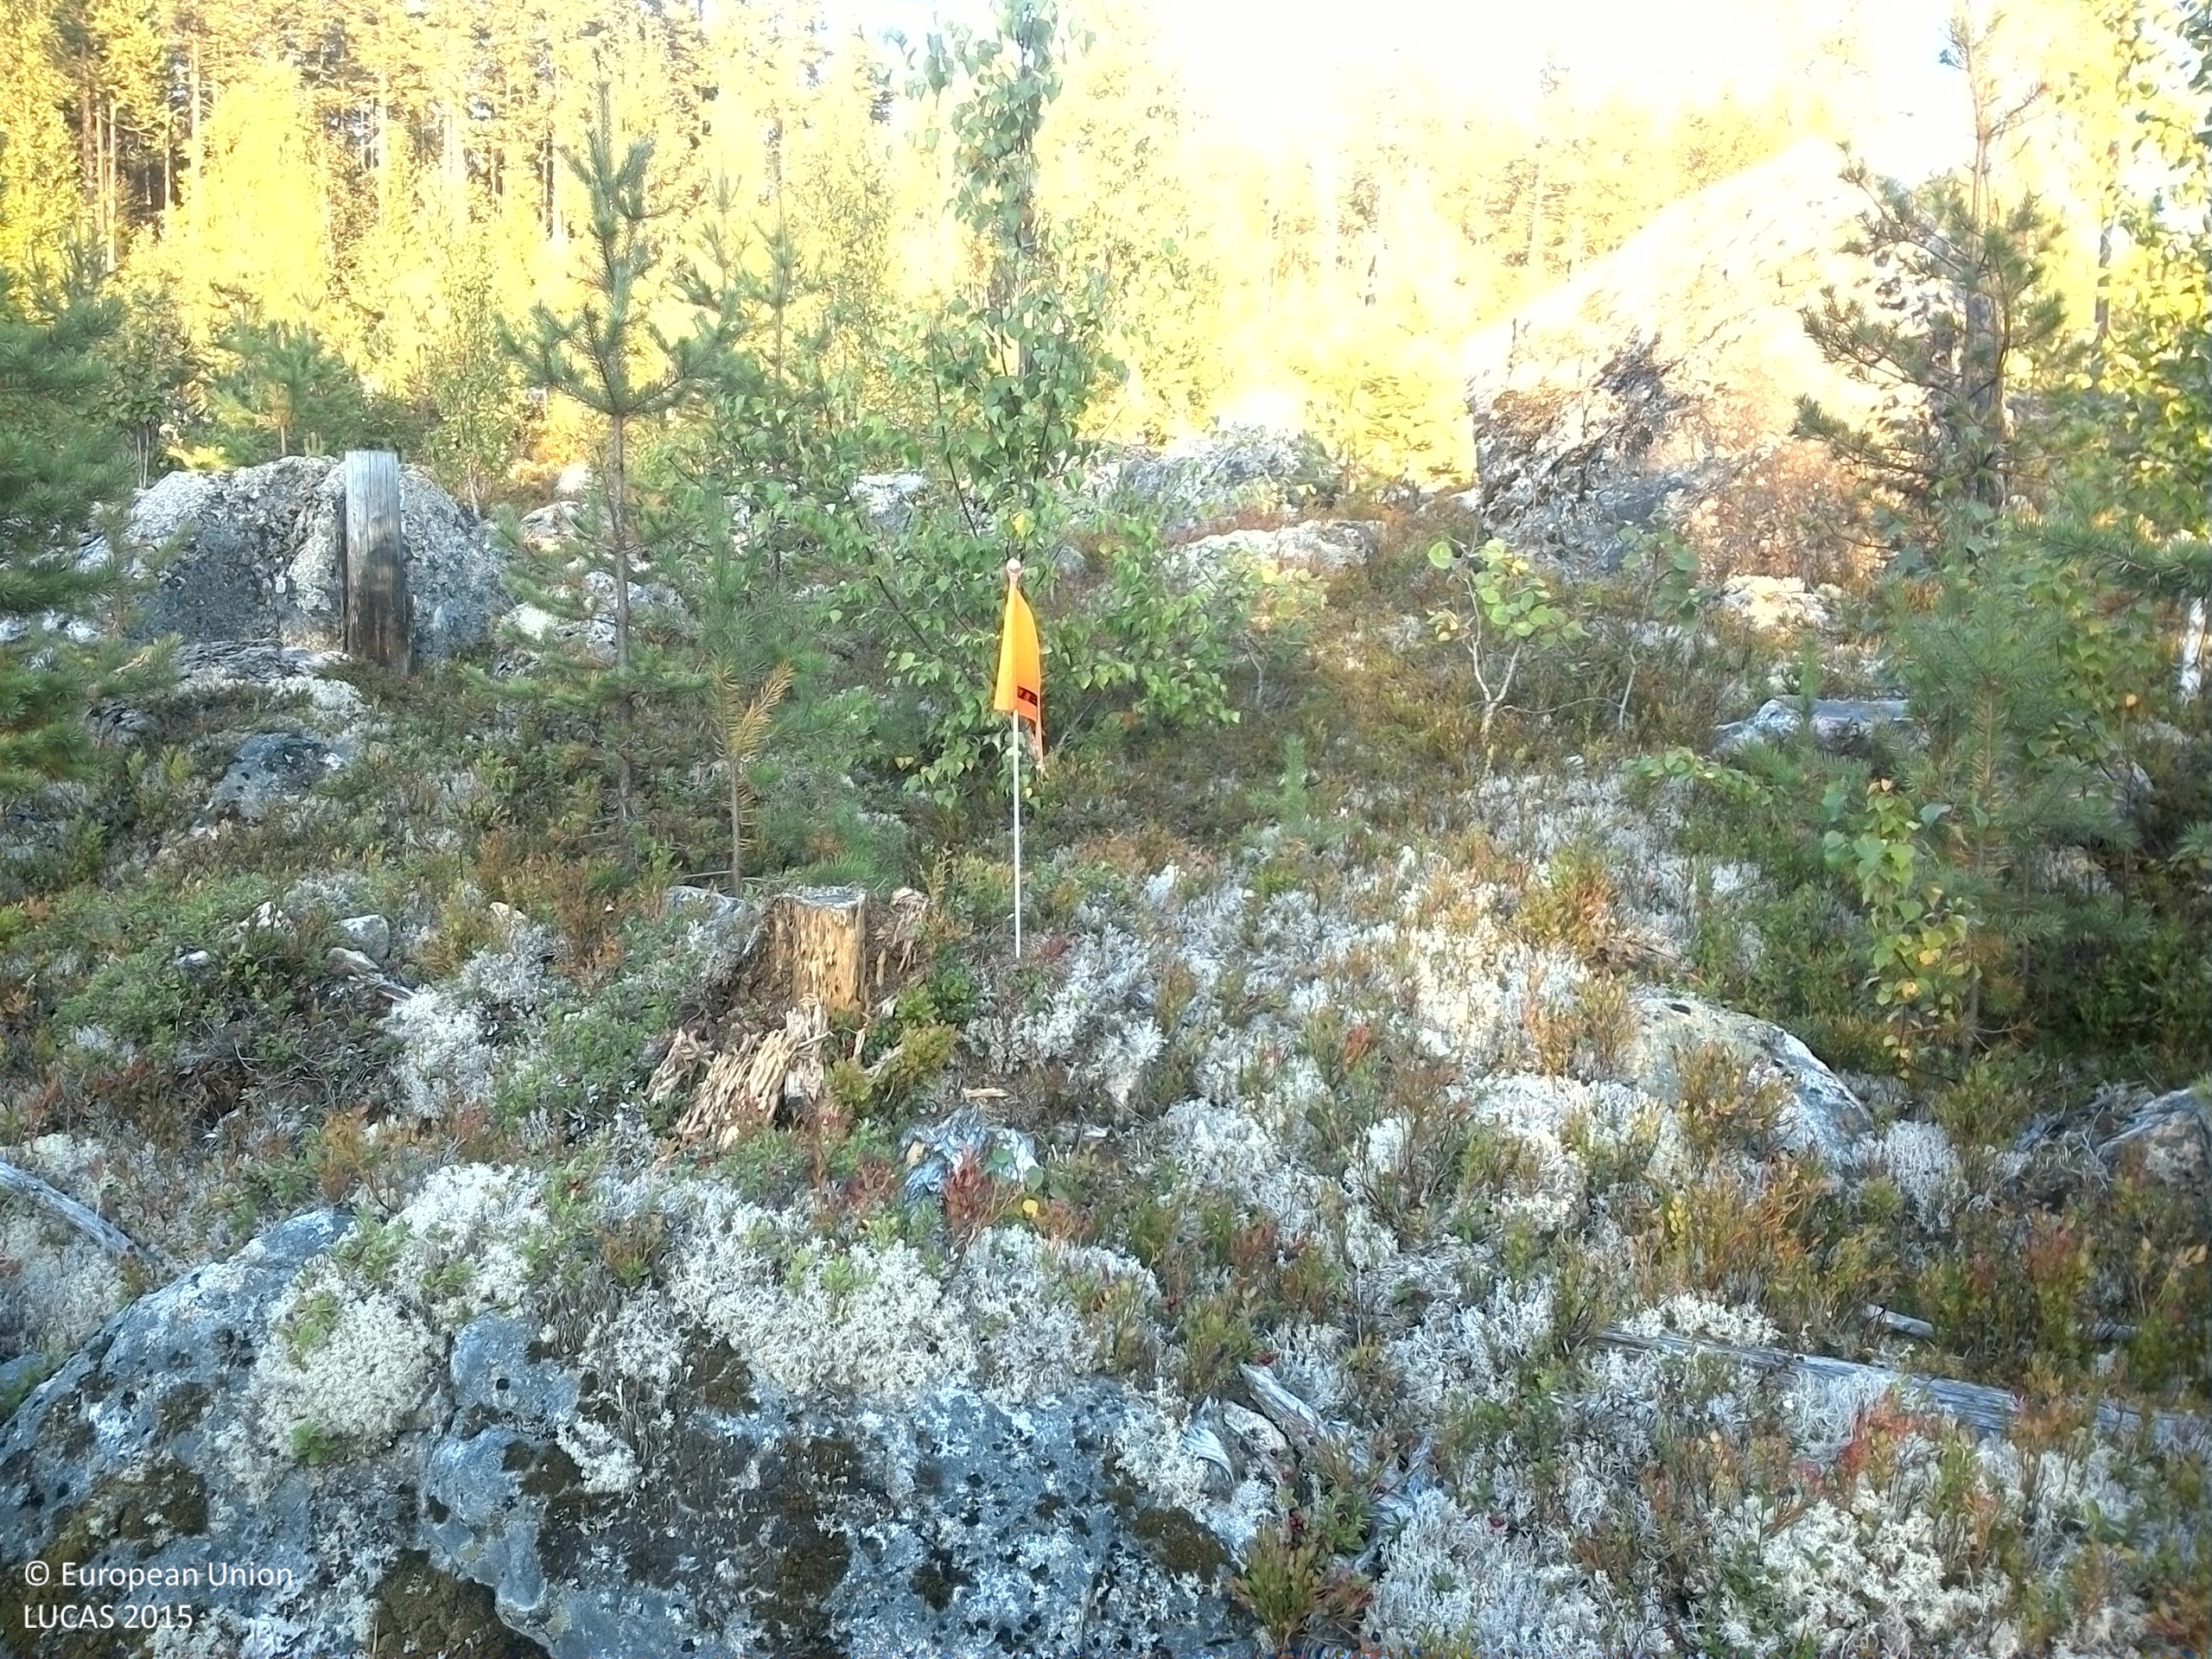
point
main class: Woodland
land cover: Pine dominated mixed woodland
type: boreal forest
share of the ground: 25 - 50 %
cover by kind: coniferous forest trees 30 %, shrubs 30 %, broadleaved forest trees 15 %, consolidated bare surface 15 %, lichens and mosses 10 %
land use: Forestry
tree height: < 5 m
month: September
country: SE
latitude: 61.6481
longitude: 15.4010
